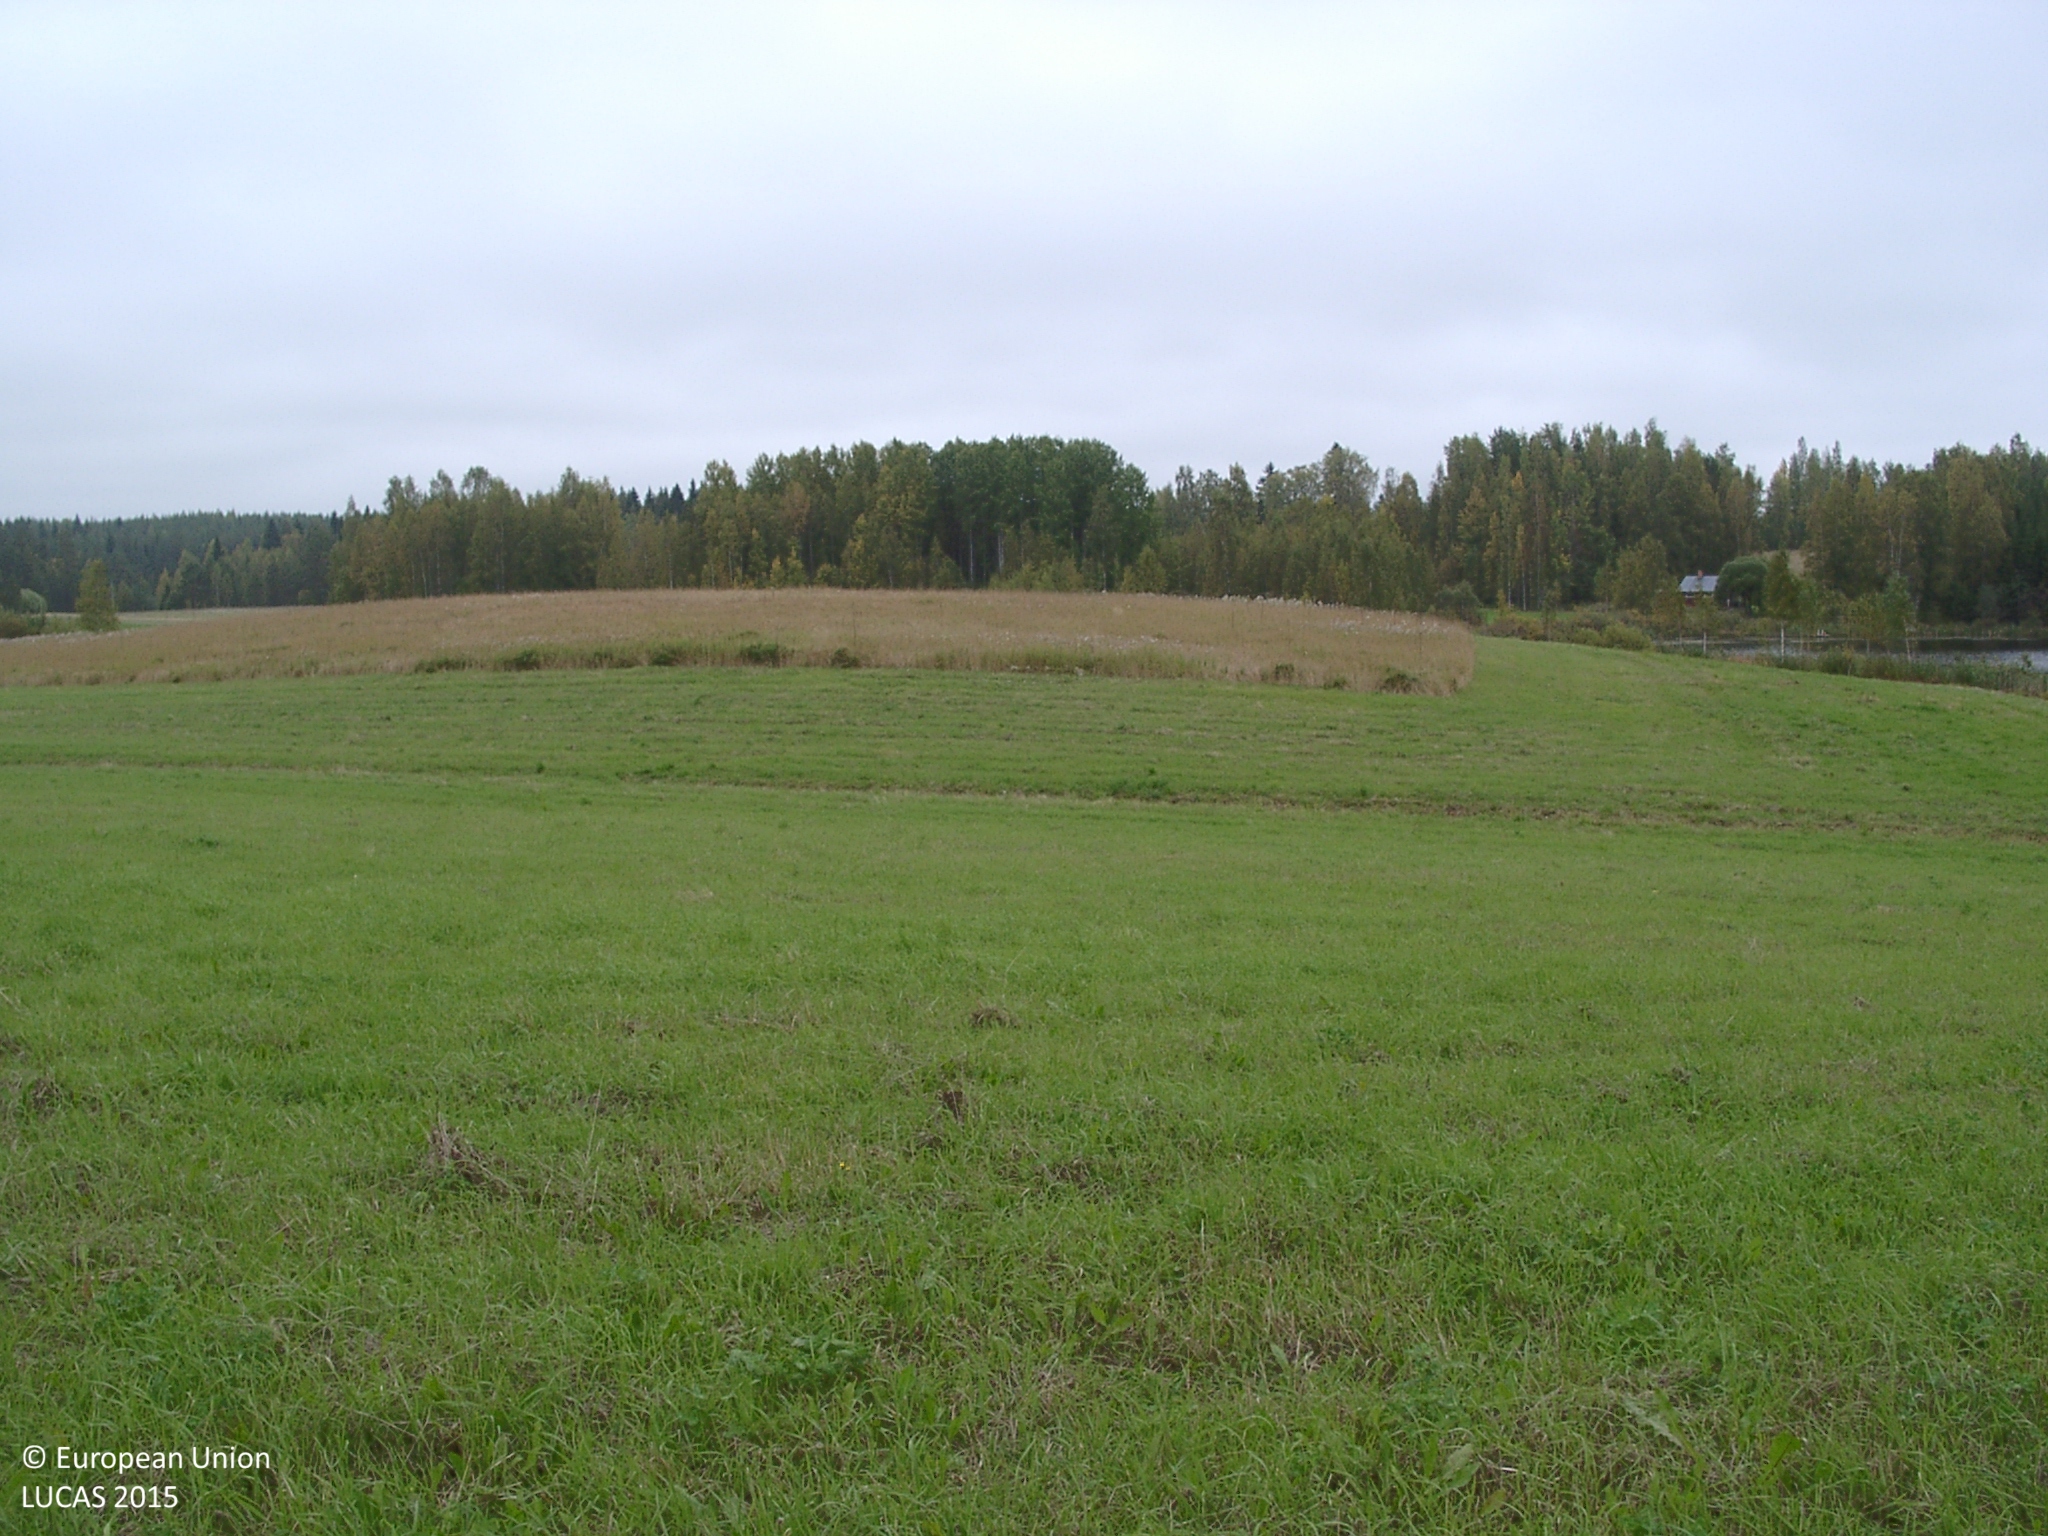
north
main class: Cropland
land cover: Other leguminous and mixtures for fodder
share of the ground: > 75 %
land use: Agriculture (excluding fallow land and kitchen gardens)
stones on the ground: < 10 %
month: September
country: FI
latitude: 62.5781
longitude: 25.6663
